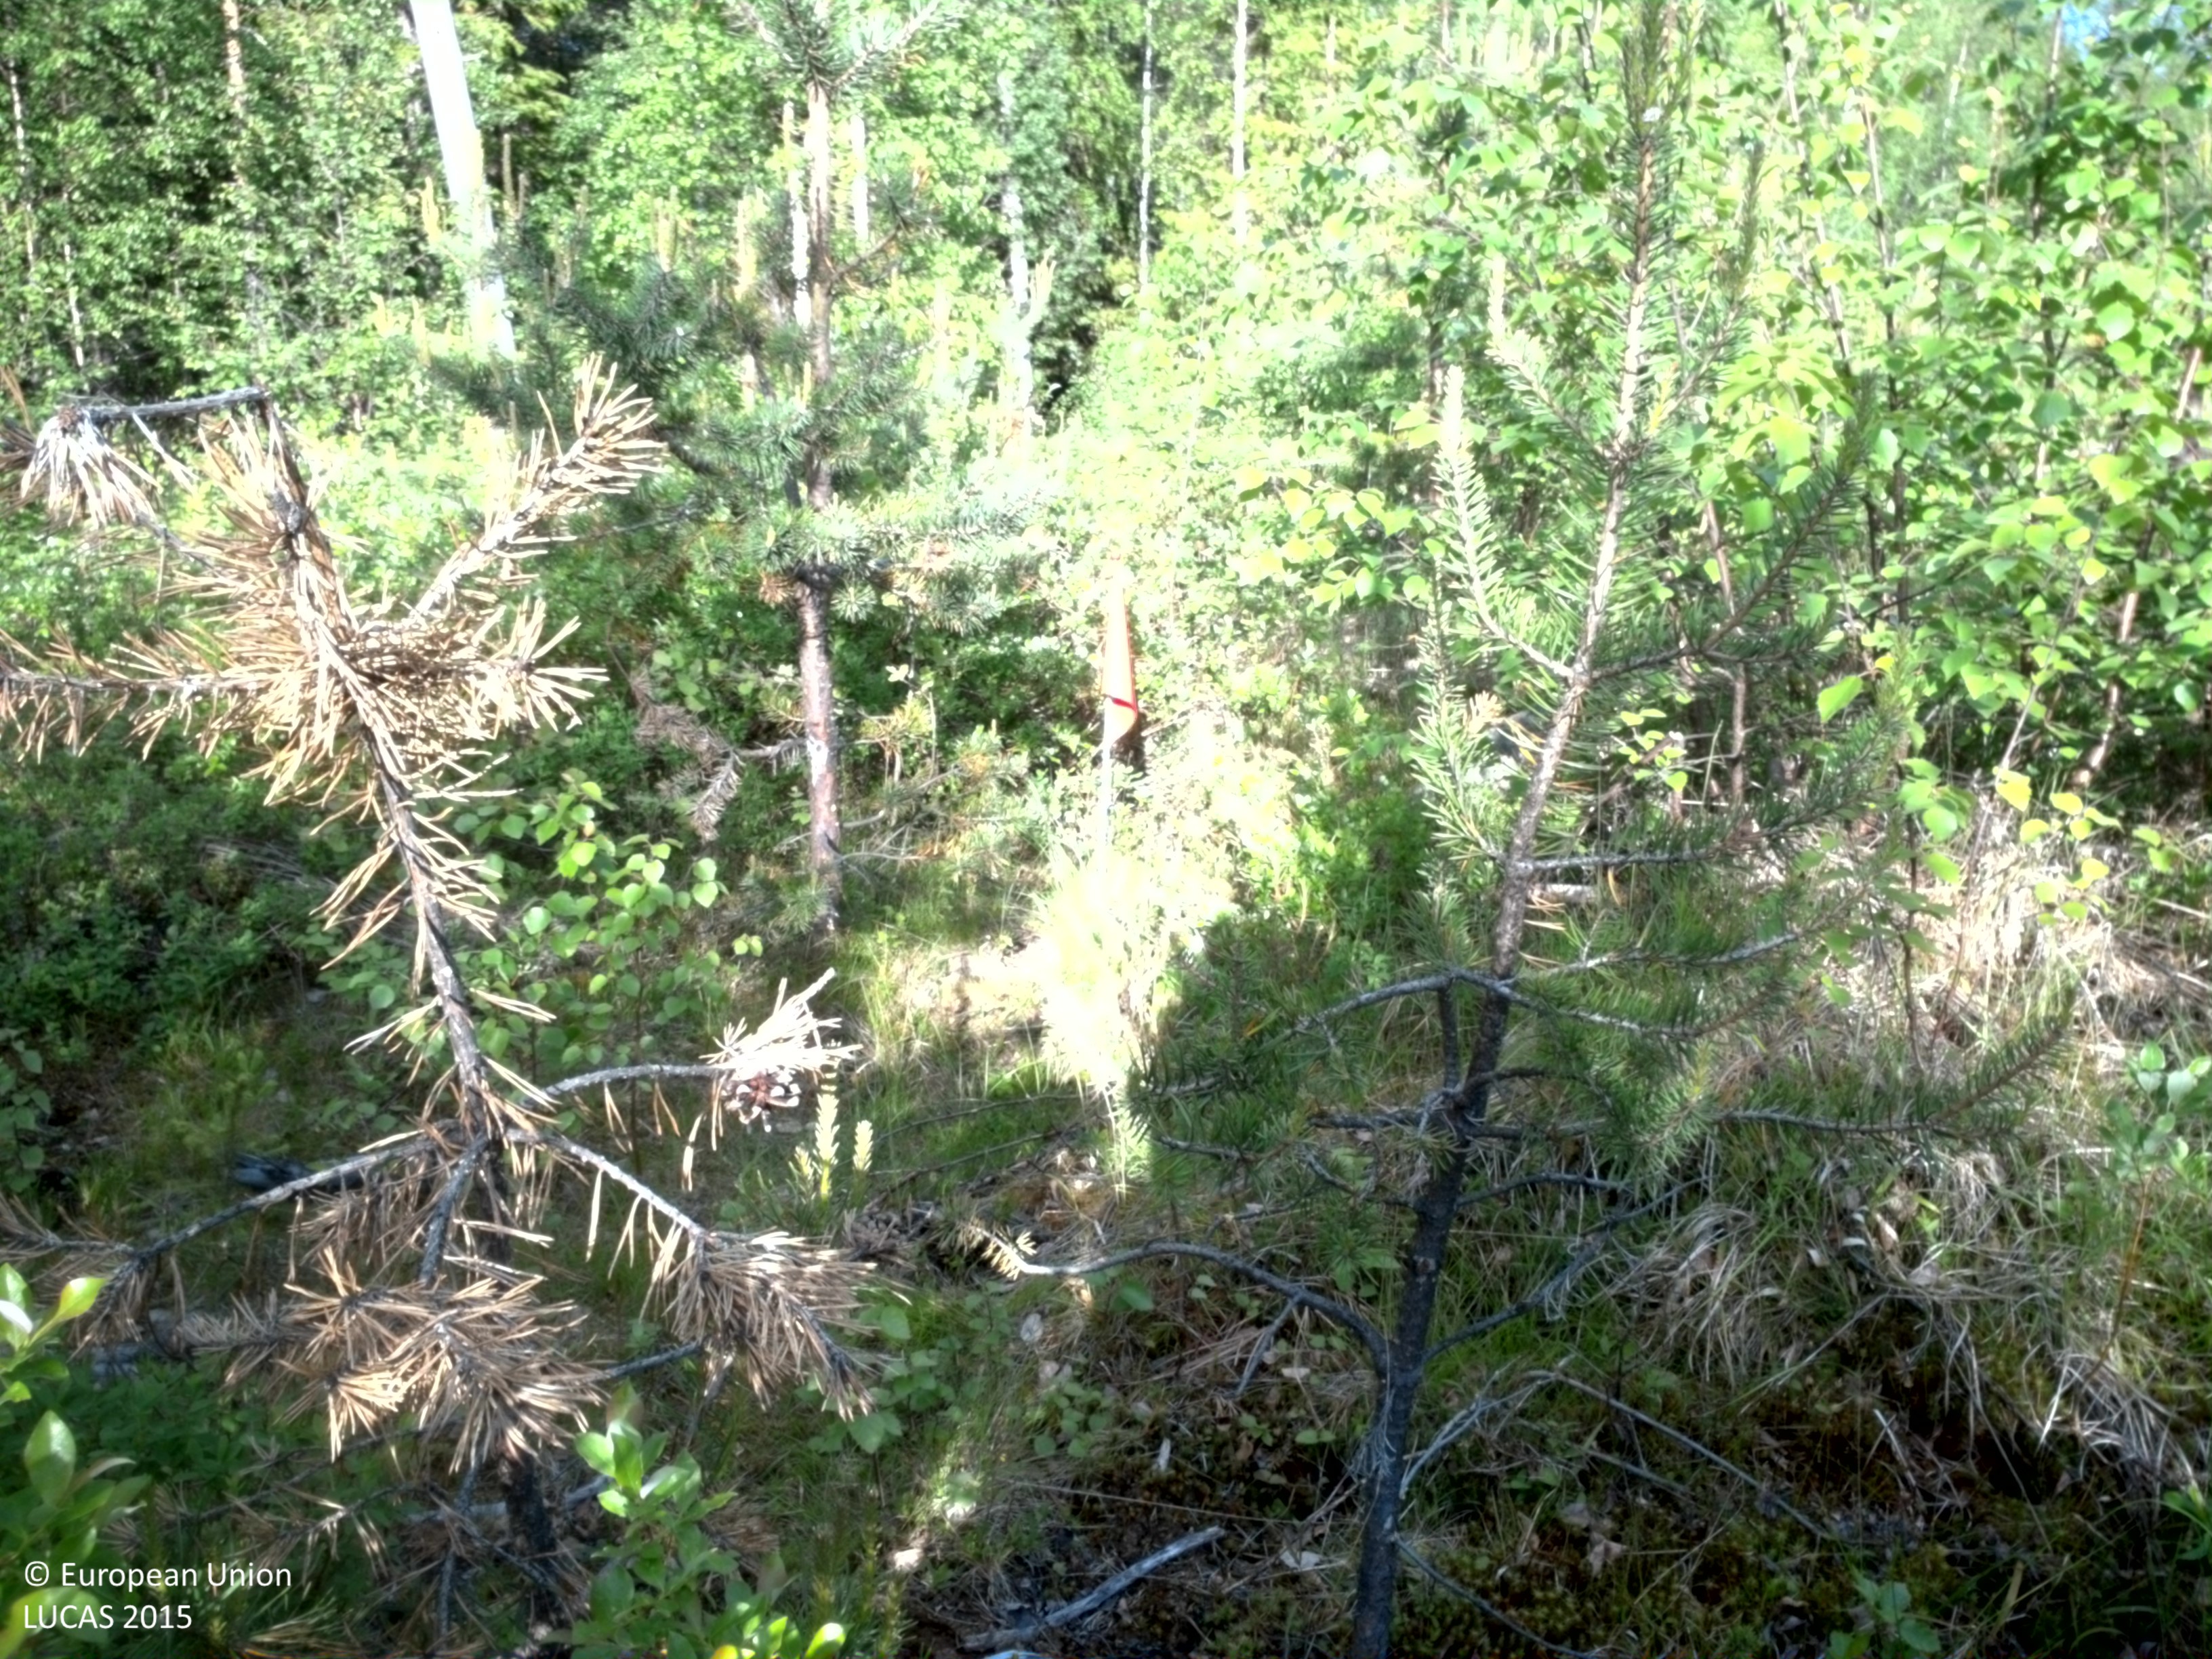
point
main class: Woodland
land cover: Pine dominated mixed woodland
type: boreal forest
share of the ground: 50 - 75 %
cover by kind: broadleaved forest trees 45 %, shrubs 30 %, coniferous forest trees 20 %, lichens and mosses 5 %
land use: Forestry
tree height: < 5 m
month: June
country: SE
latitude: 66.3827
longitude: 22.7034
